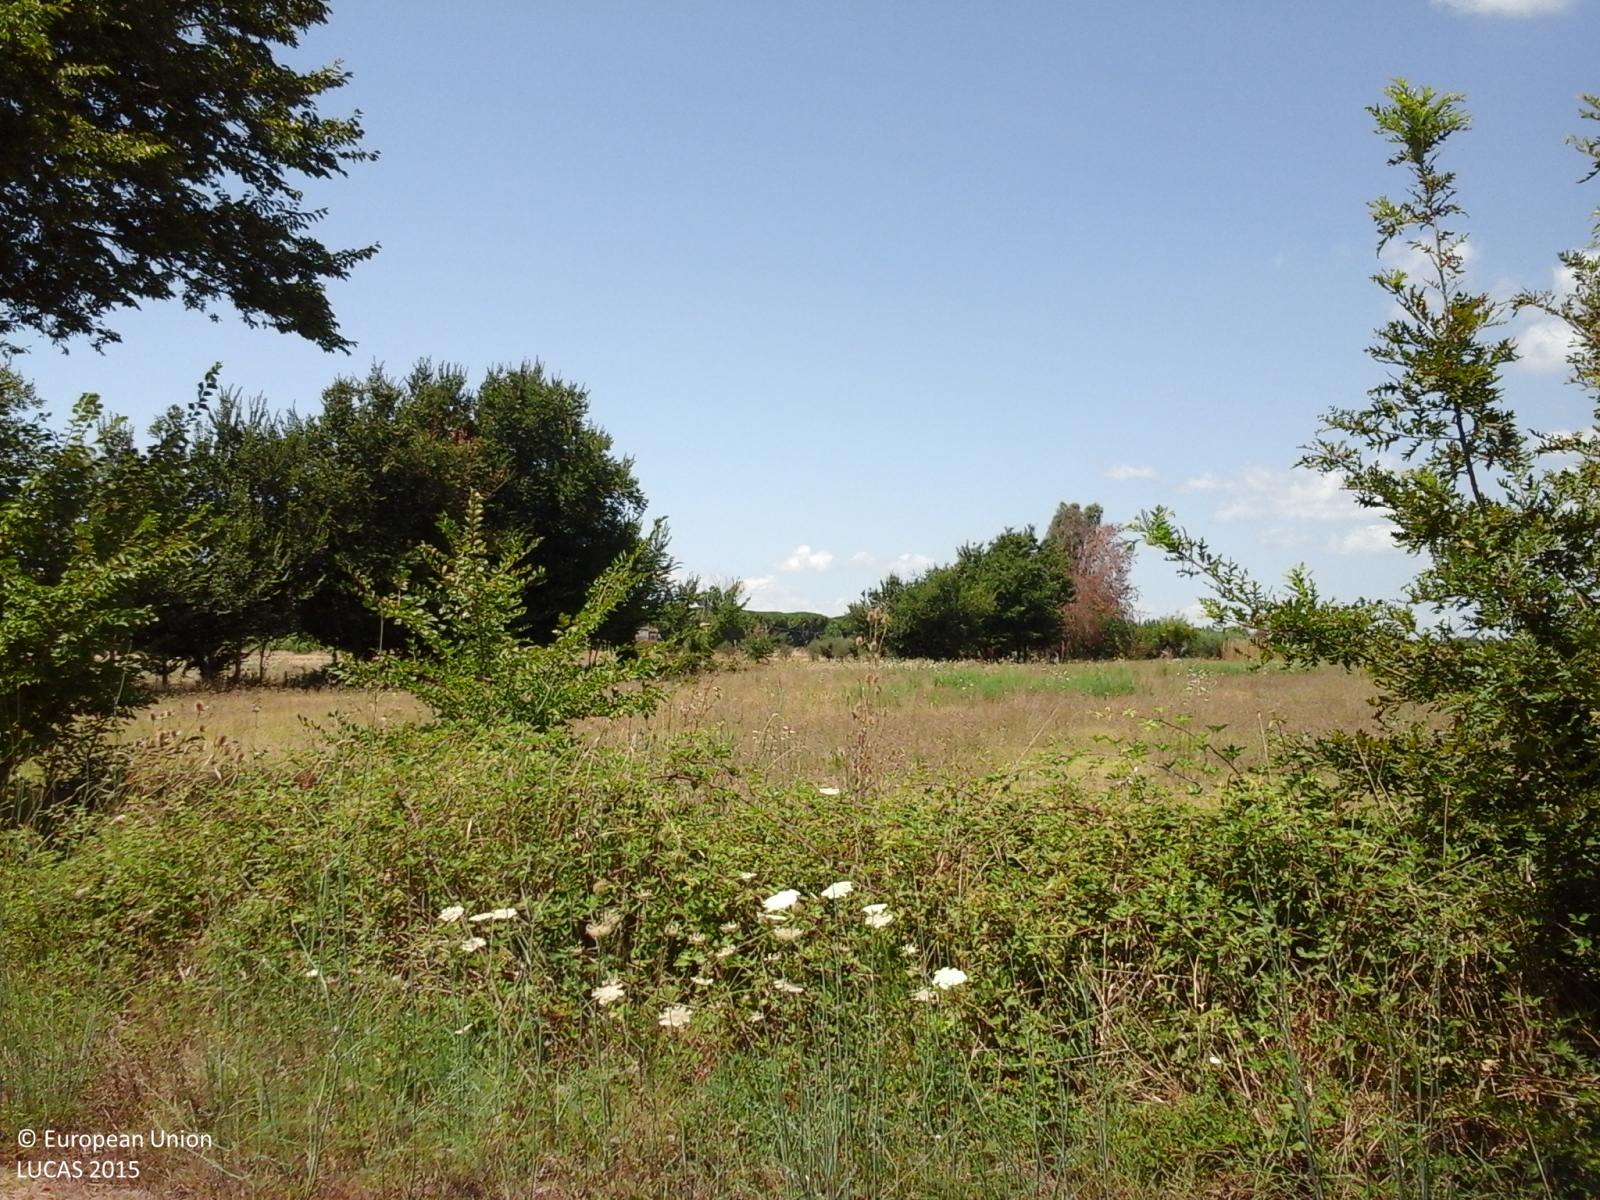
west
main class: Grassland
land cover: Grassland without tree/shrub cover
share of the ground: > 75 %
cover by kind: herbaceous plants 100 %
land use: Air transport
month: July
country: IT
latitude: 41.5458
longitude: 12.9016
